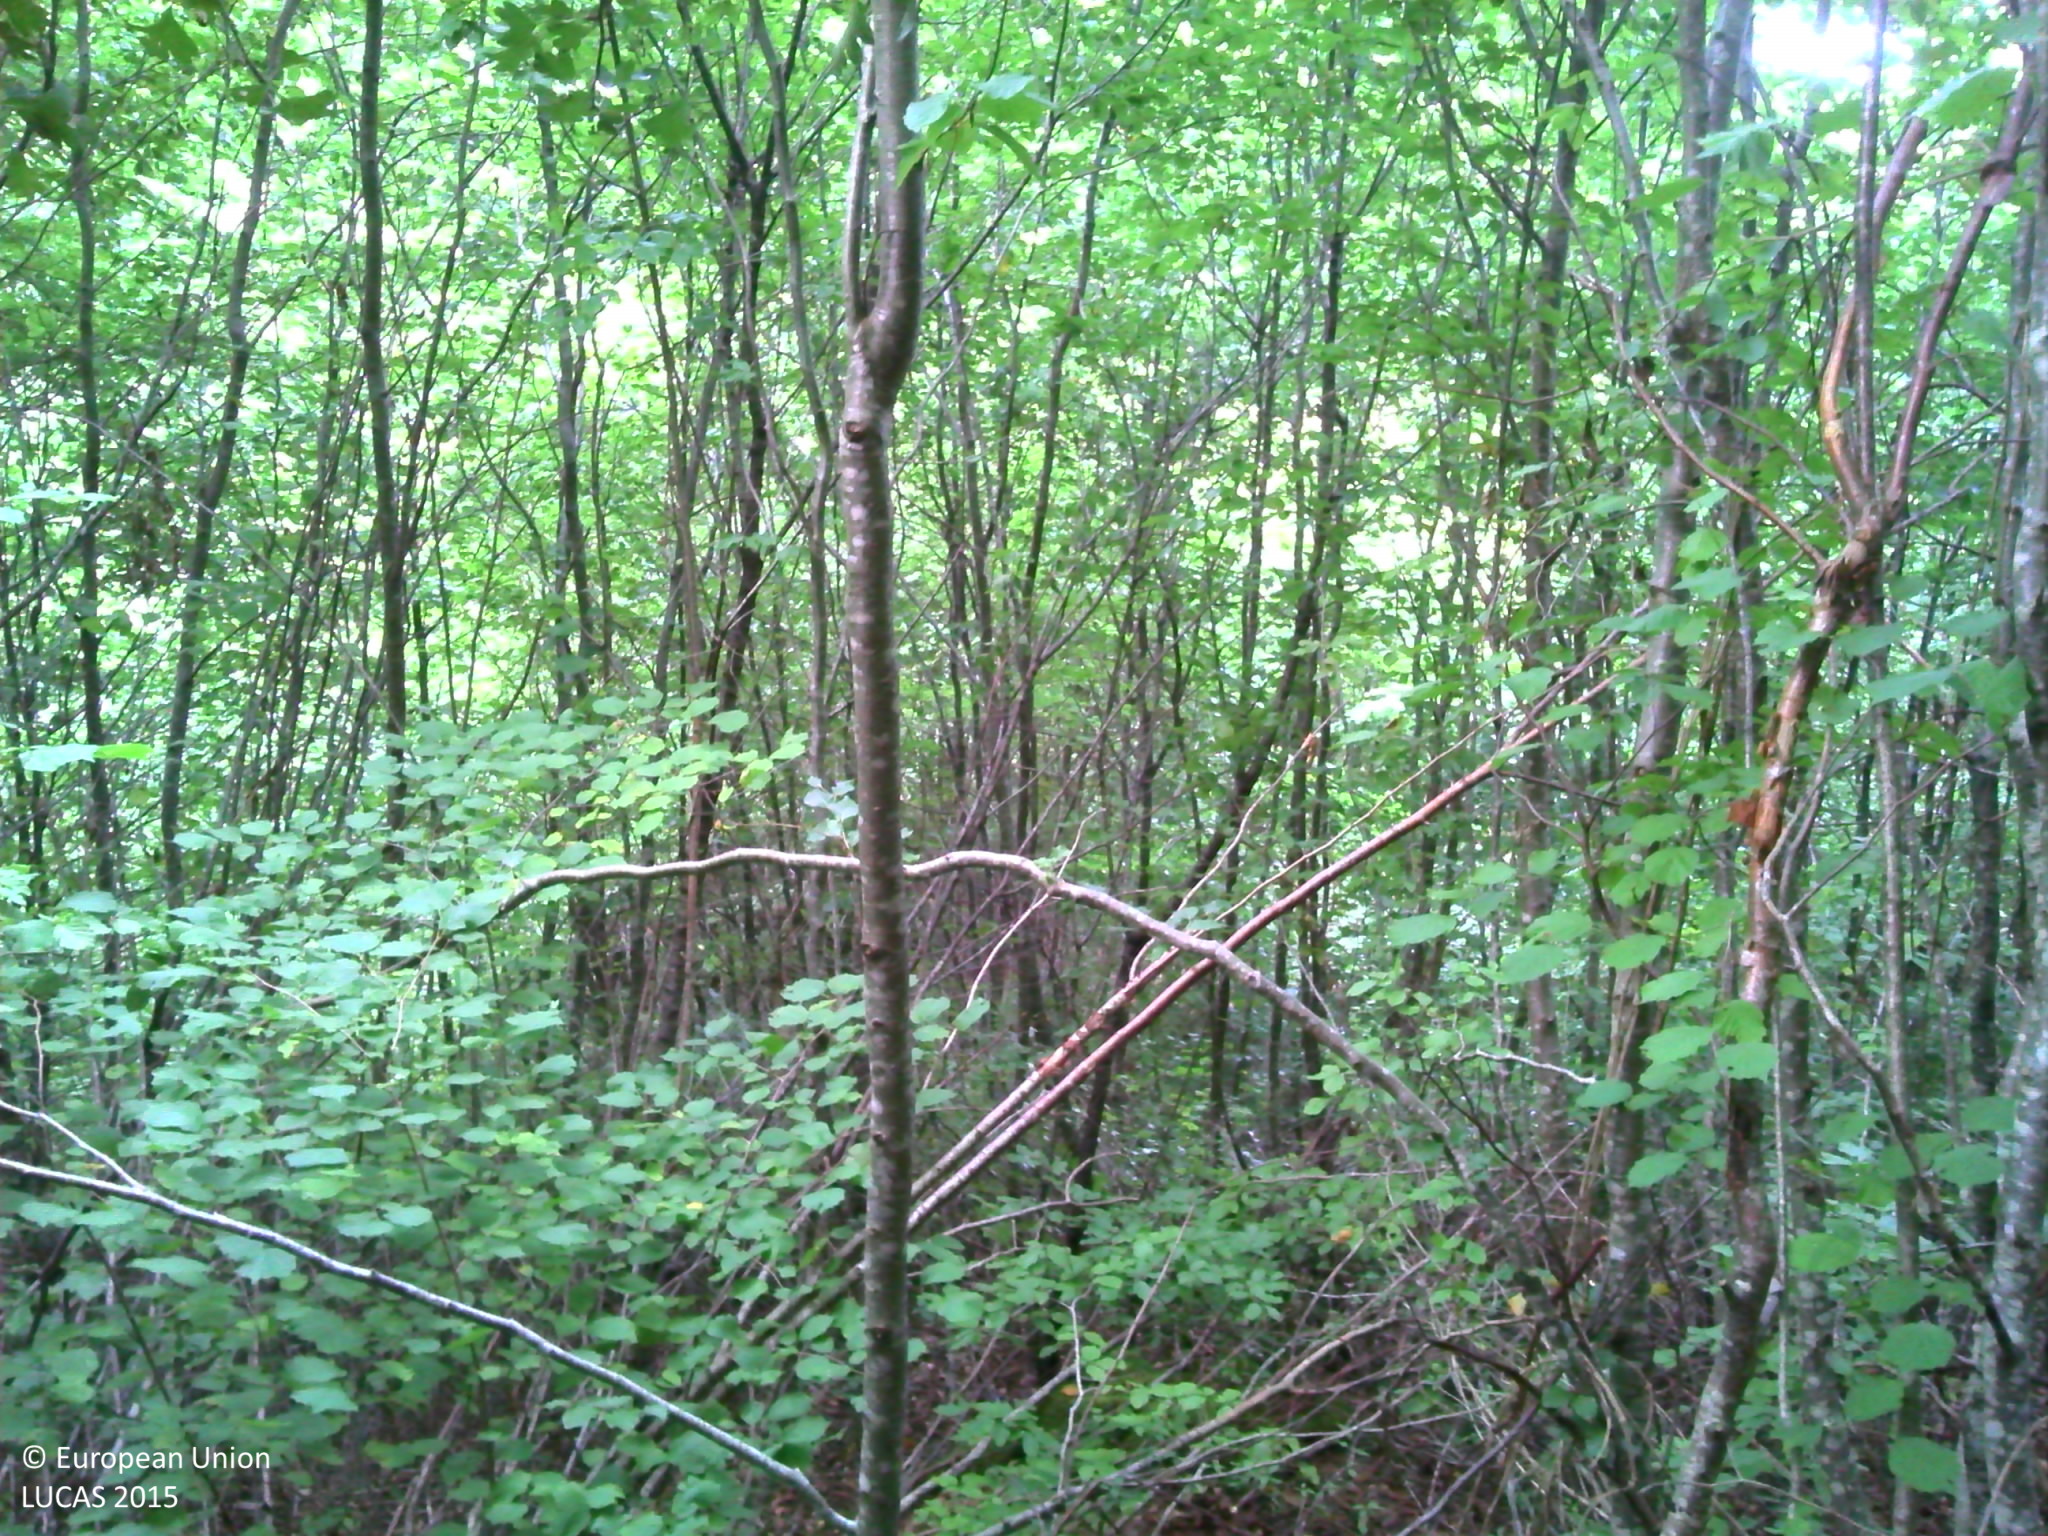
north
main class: Woodland
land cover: Broadleaved woodland
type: mesophytic deciduous forest
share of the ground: > 75 %
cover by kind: broadleaved forest trees 90 %, herbaceous plants 5 %, lichens and mosses 5 %
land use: Forestry
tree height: > 5 m
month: September
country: FR
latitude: 47.6245
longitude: 4.2898
